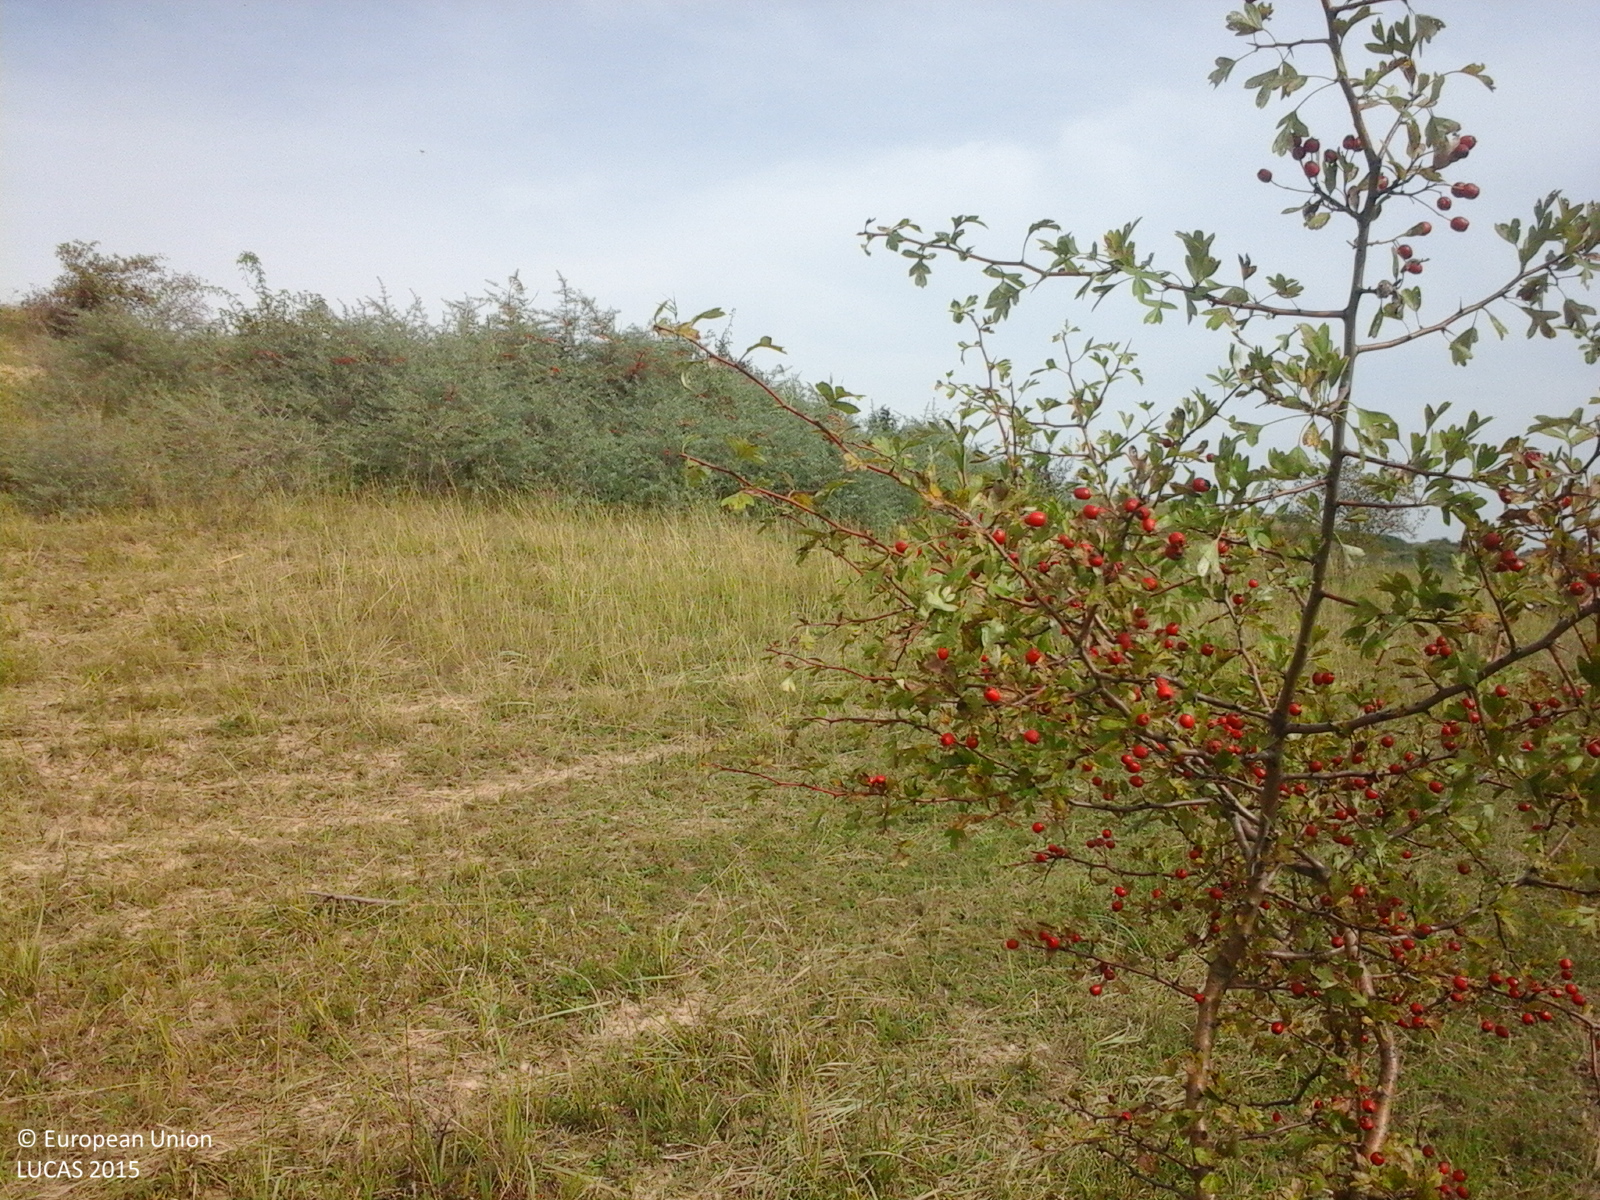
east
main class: Grassland
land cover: Grassland with sparse tree/shrub cover
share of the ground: > 75 %
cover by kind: herbaceous plants 85 %, shrubs 10 %, broadleaved forest trees 5 %
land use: Agriculture (excluding fallow land and kitchen gardens)
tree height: < 5 m
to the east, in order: Grassland with sparse tree/shrub cover; Shrubland with sparse tree cover; Shrubland without tree cover; Grassland with sparse tree/shrub cover
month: September
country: RO
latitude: 46.8941
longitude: 23.6577
